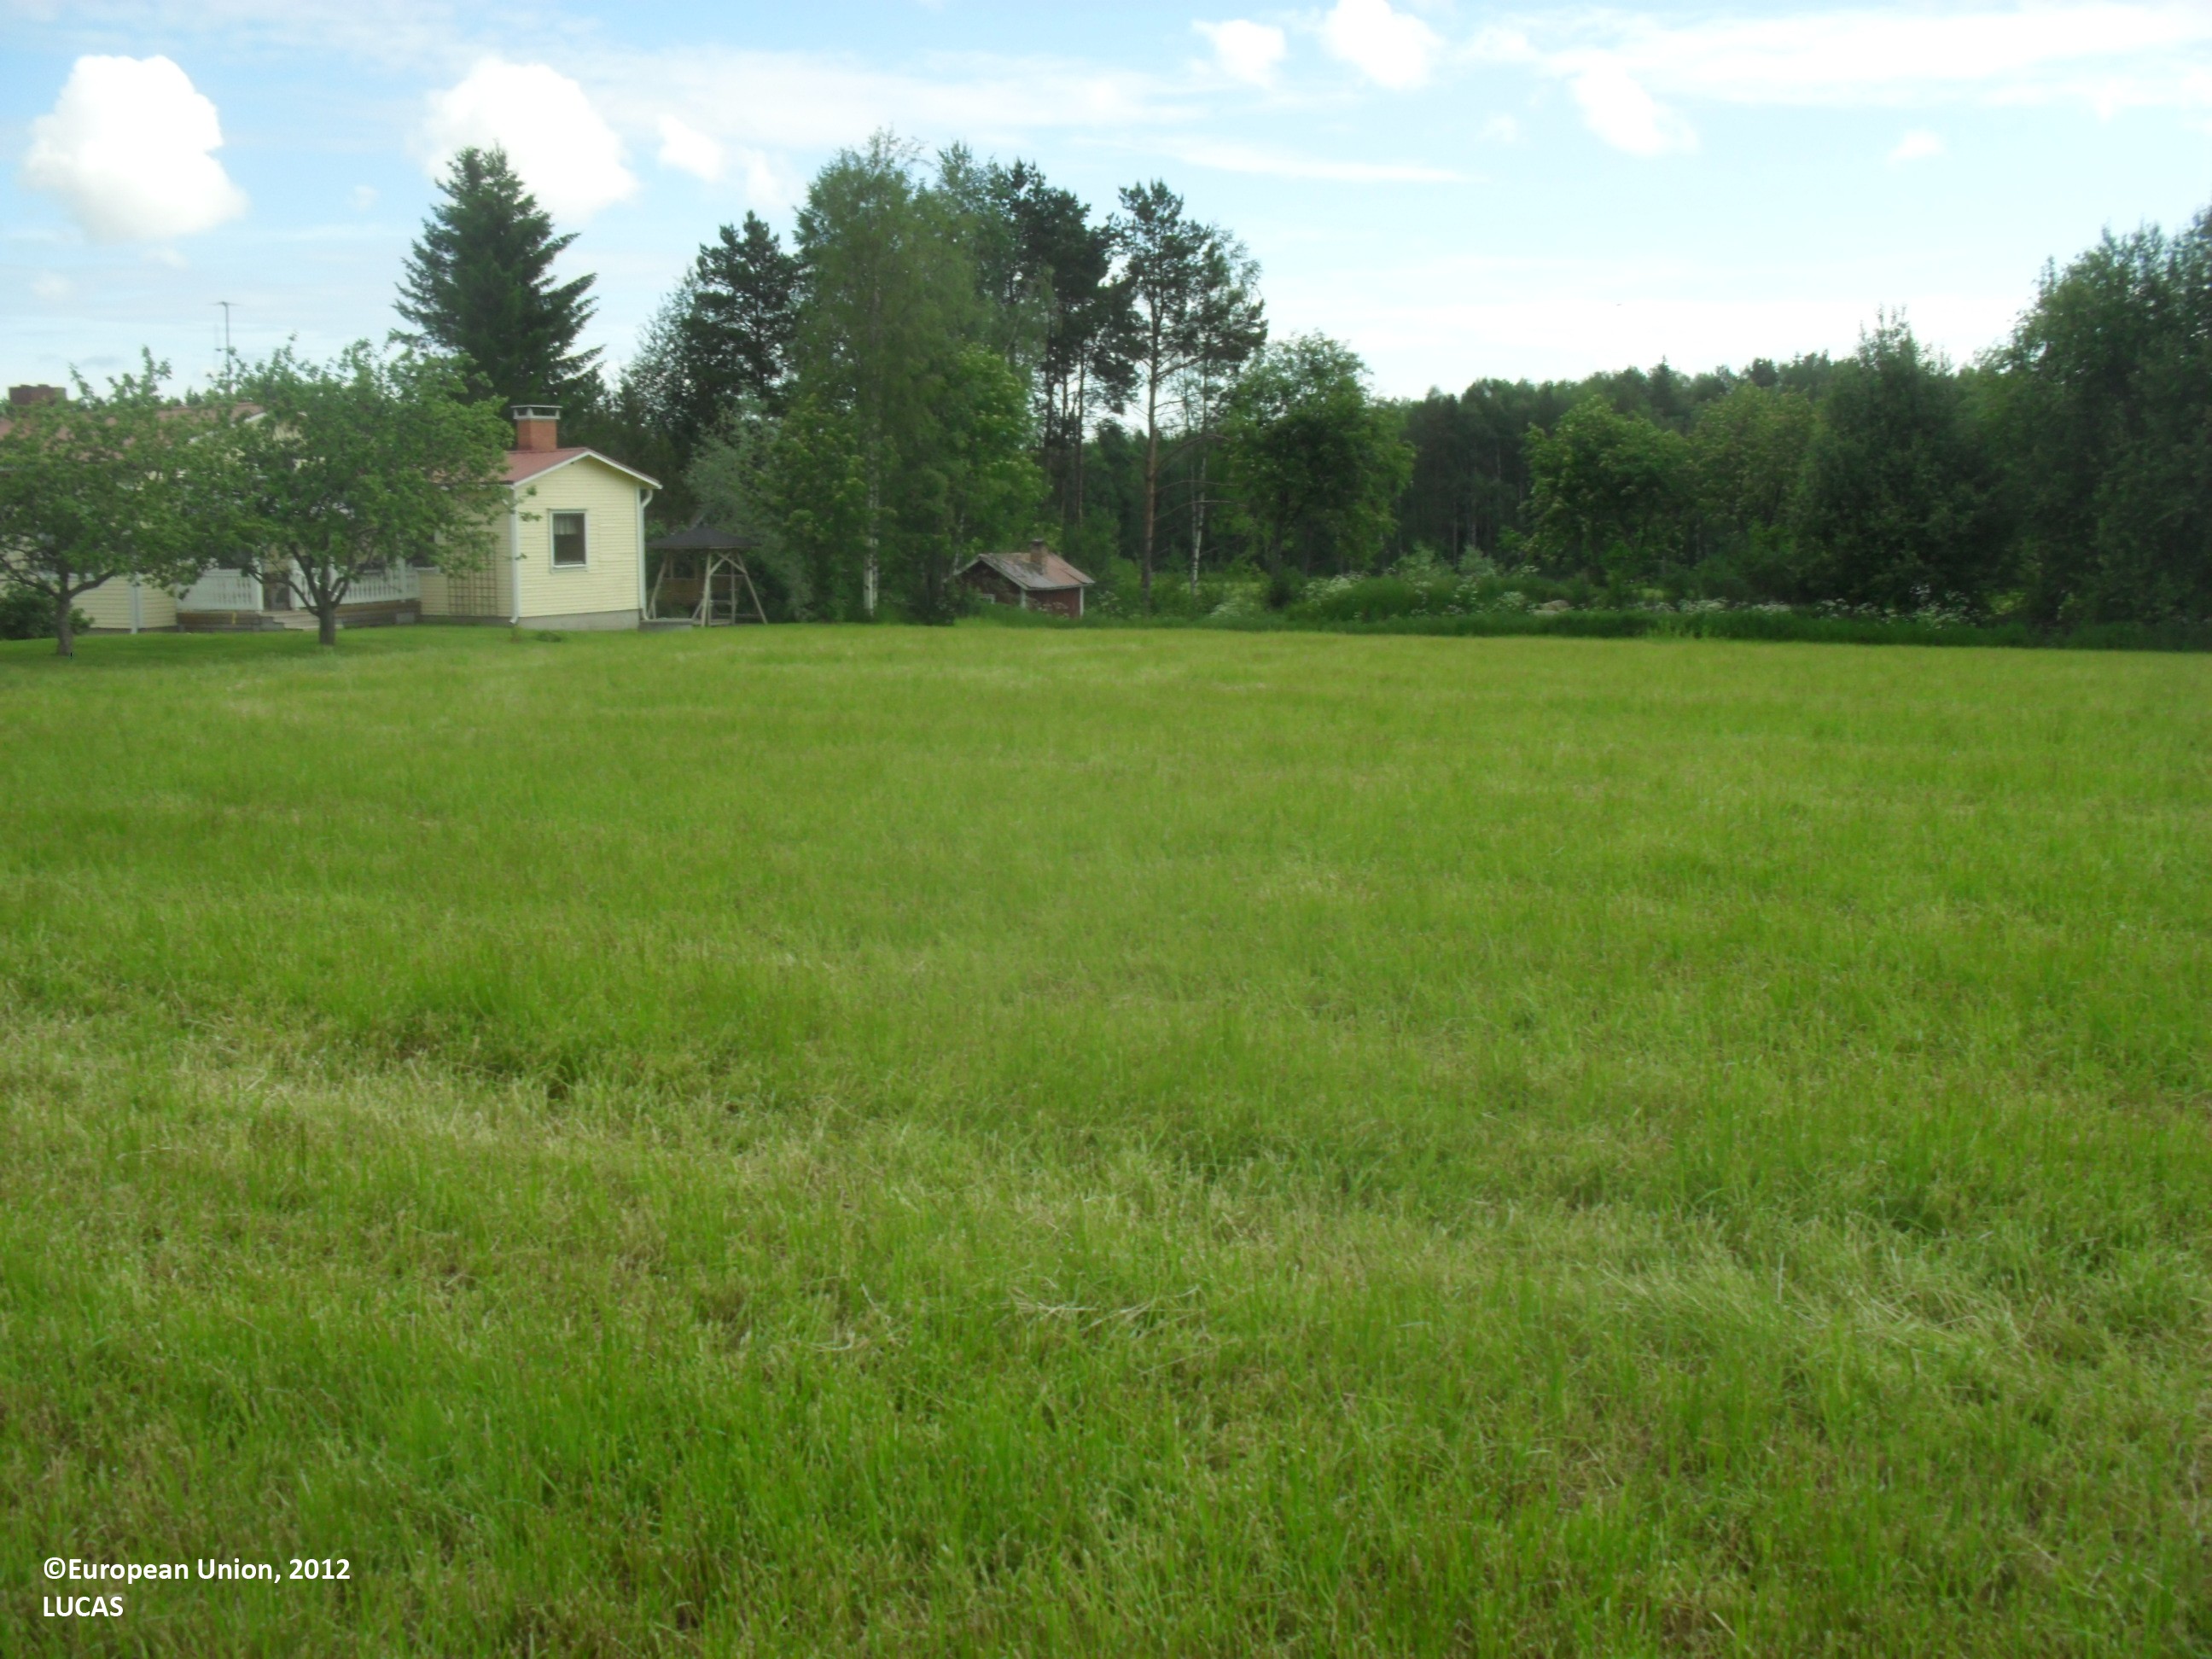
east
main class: Cropland
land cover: Temporary grasslands
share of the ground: > 75 %
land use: Agriculture (excluding fallow land and kitchen gardens)
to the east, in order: Temporary grasslands; Spontaneously vegetated surfaces; Abandoned hedges; Broadleaved woodland; Rivers and streams; Temporary grasslands; Rivers and streams; Broadleaved woodland; Inland marshes
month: June
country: FI
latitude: 63.3290
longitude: 23.4213
